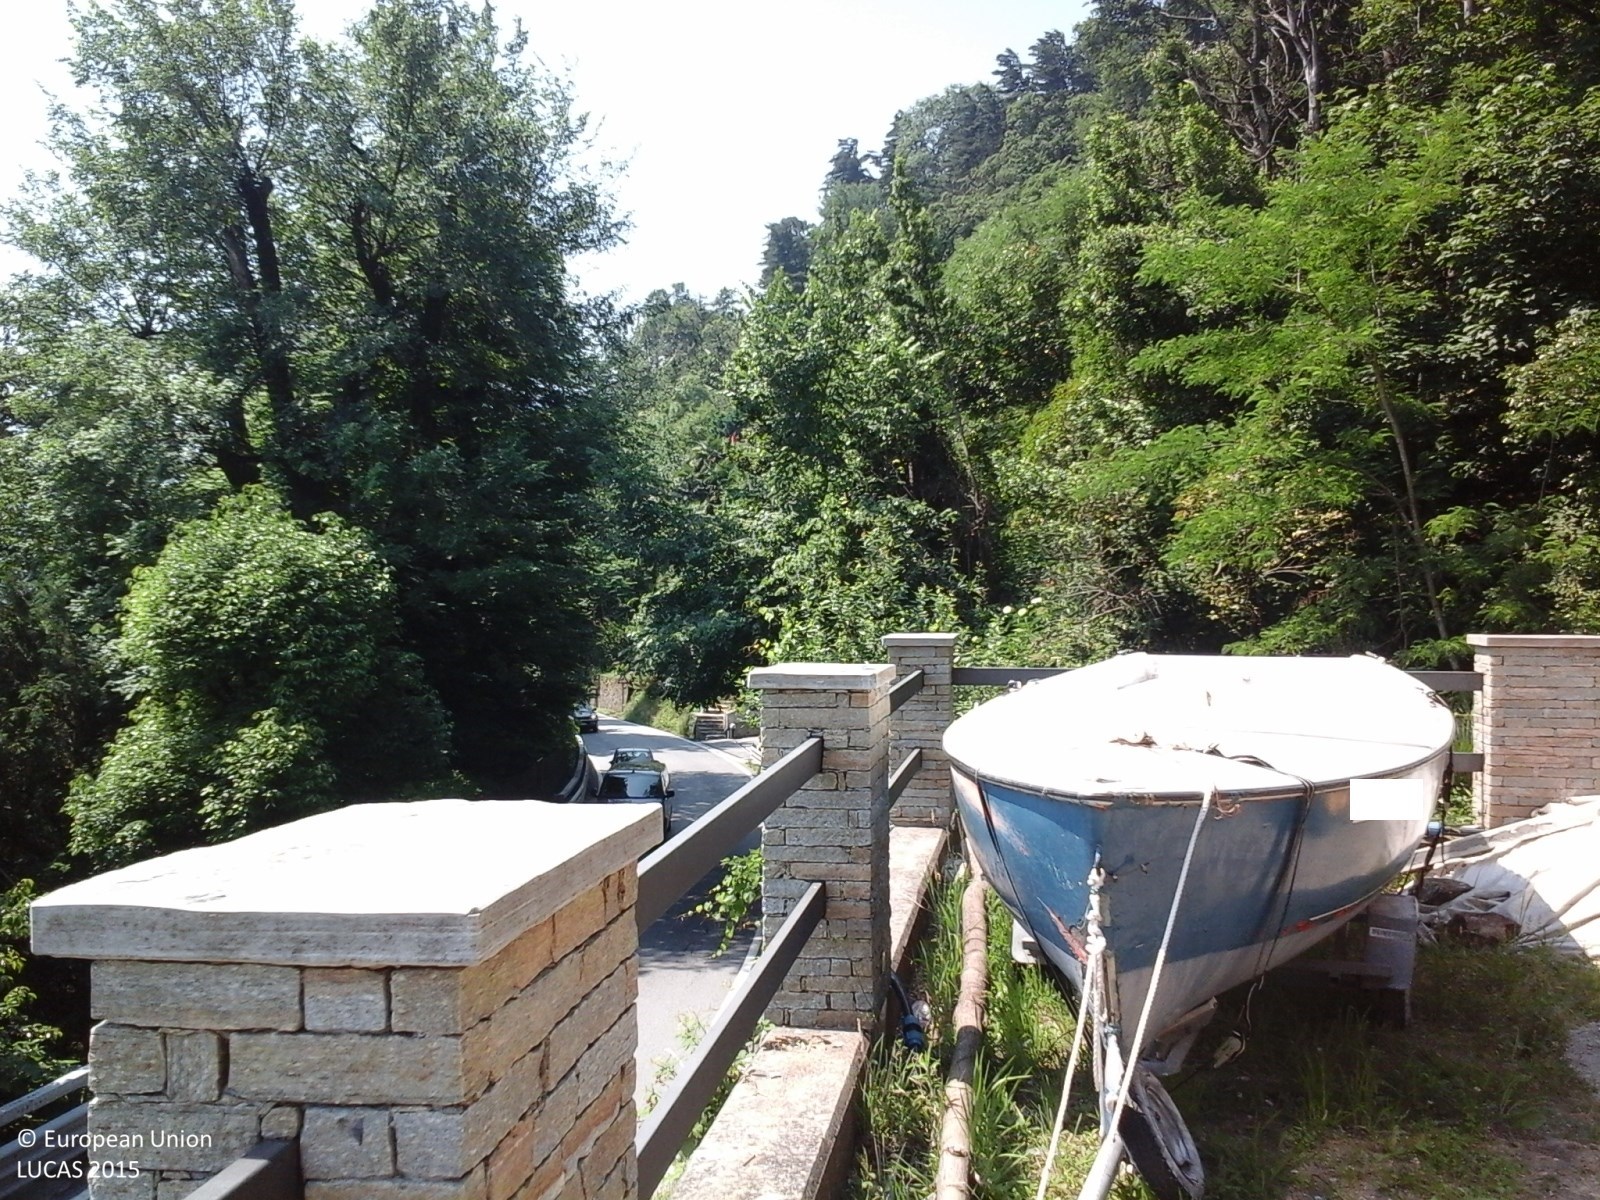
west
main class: Woodland
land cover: Other mixed woodland
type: thermophilous deciduous forest
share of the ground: > 75 %
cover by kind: broadleaved forest trees 75 %, coniferous forest trees 25 %
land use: Forestry
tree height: > 5 m
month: June
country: IT
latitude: 46.0187
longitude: 8.6715
